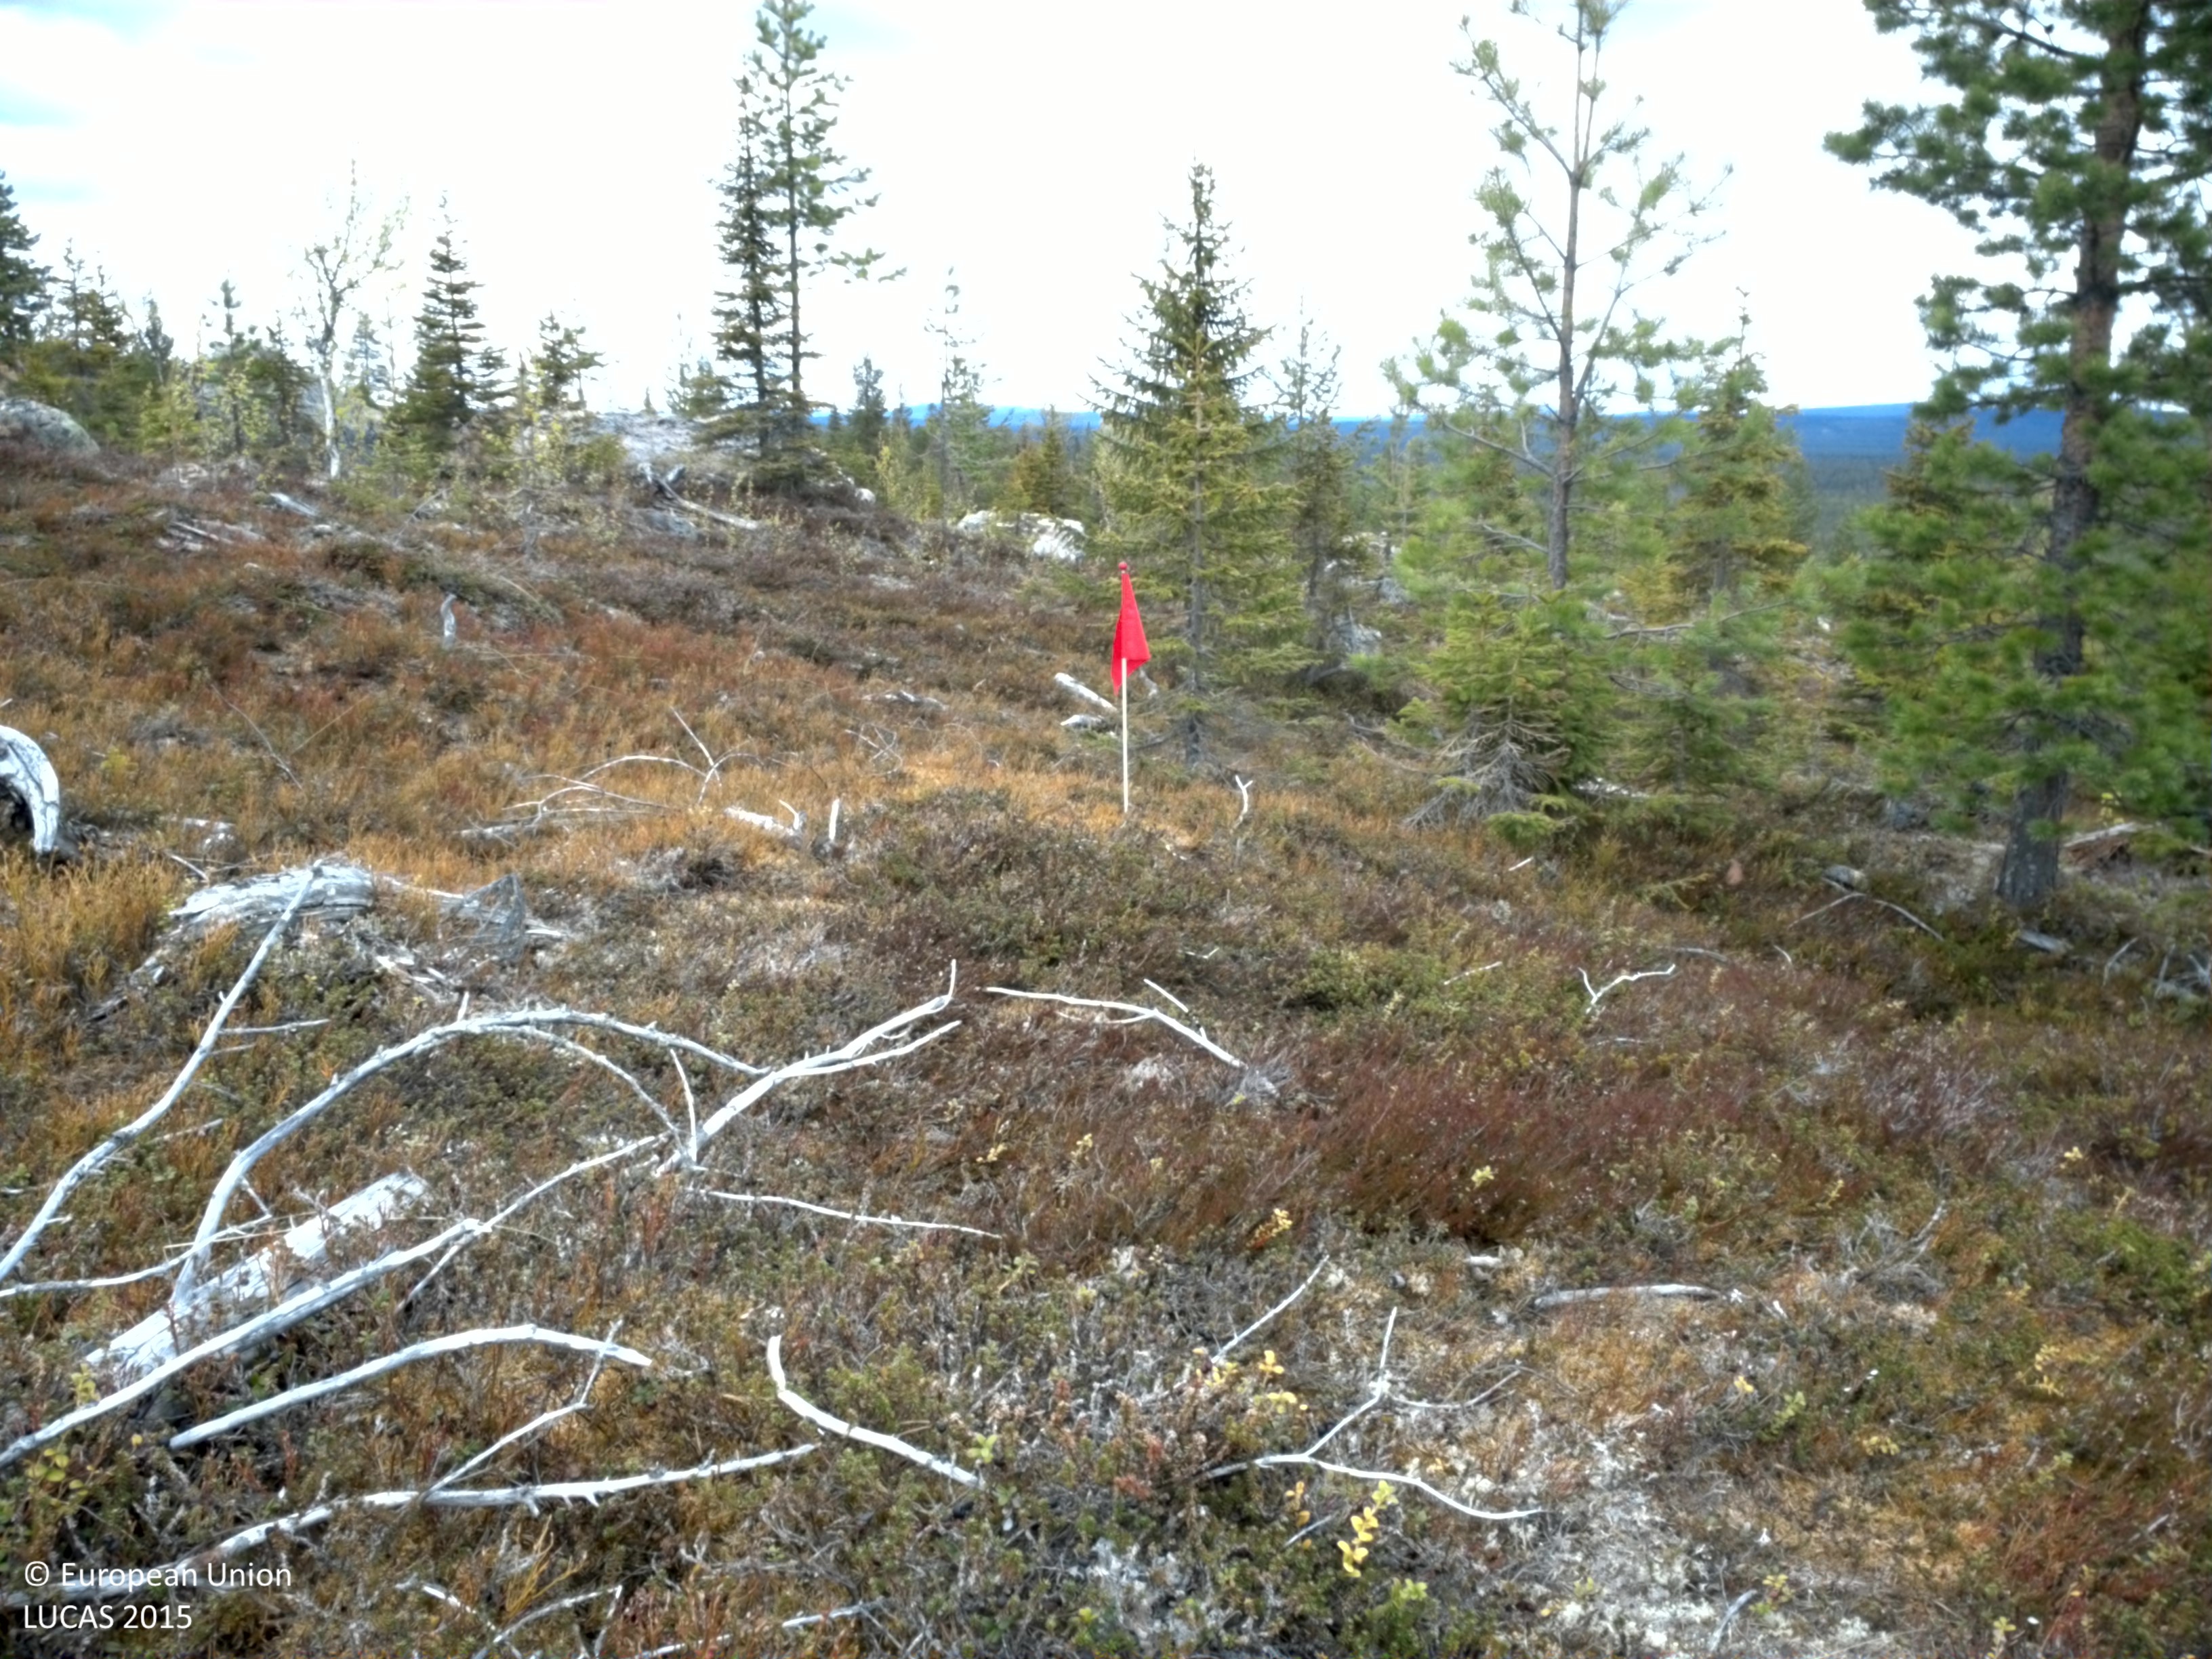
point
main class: Woodland
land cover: Spruce dominated mixed woodland
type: boreal forest
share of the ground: 10 - 25 %
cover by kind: shrubs 65 %, coniferous forest trees 15 %, consolidated bare surface 10 %, broadleaved forest trees 5 %, lichens and mosses 5 %
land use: Forestry
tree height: < 5 m
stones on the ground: > 50 %
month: June
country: SE
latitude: 66.0555
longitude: 18.6333
